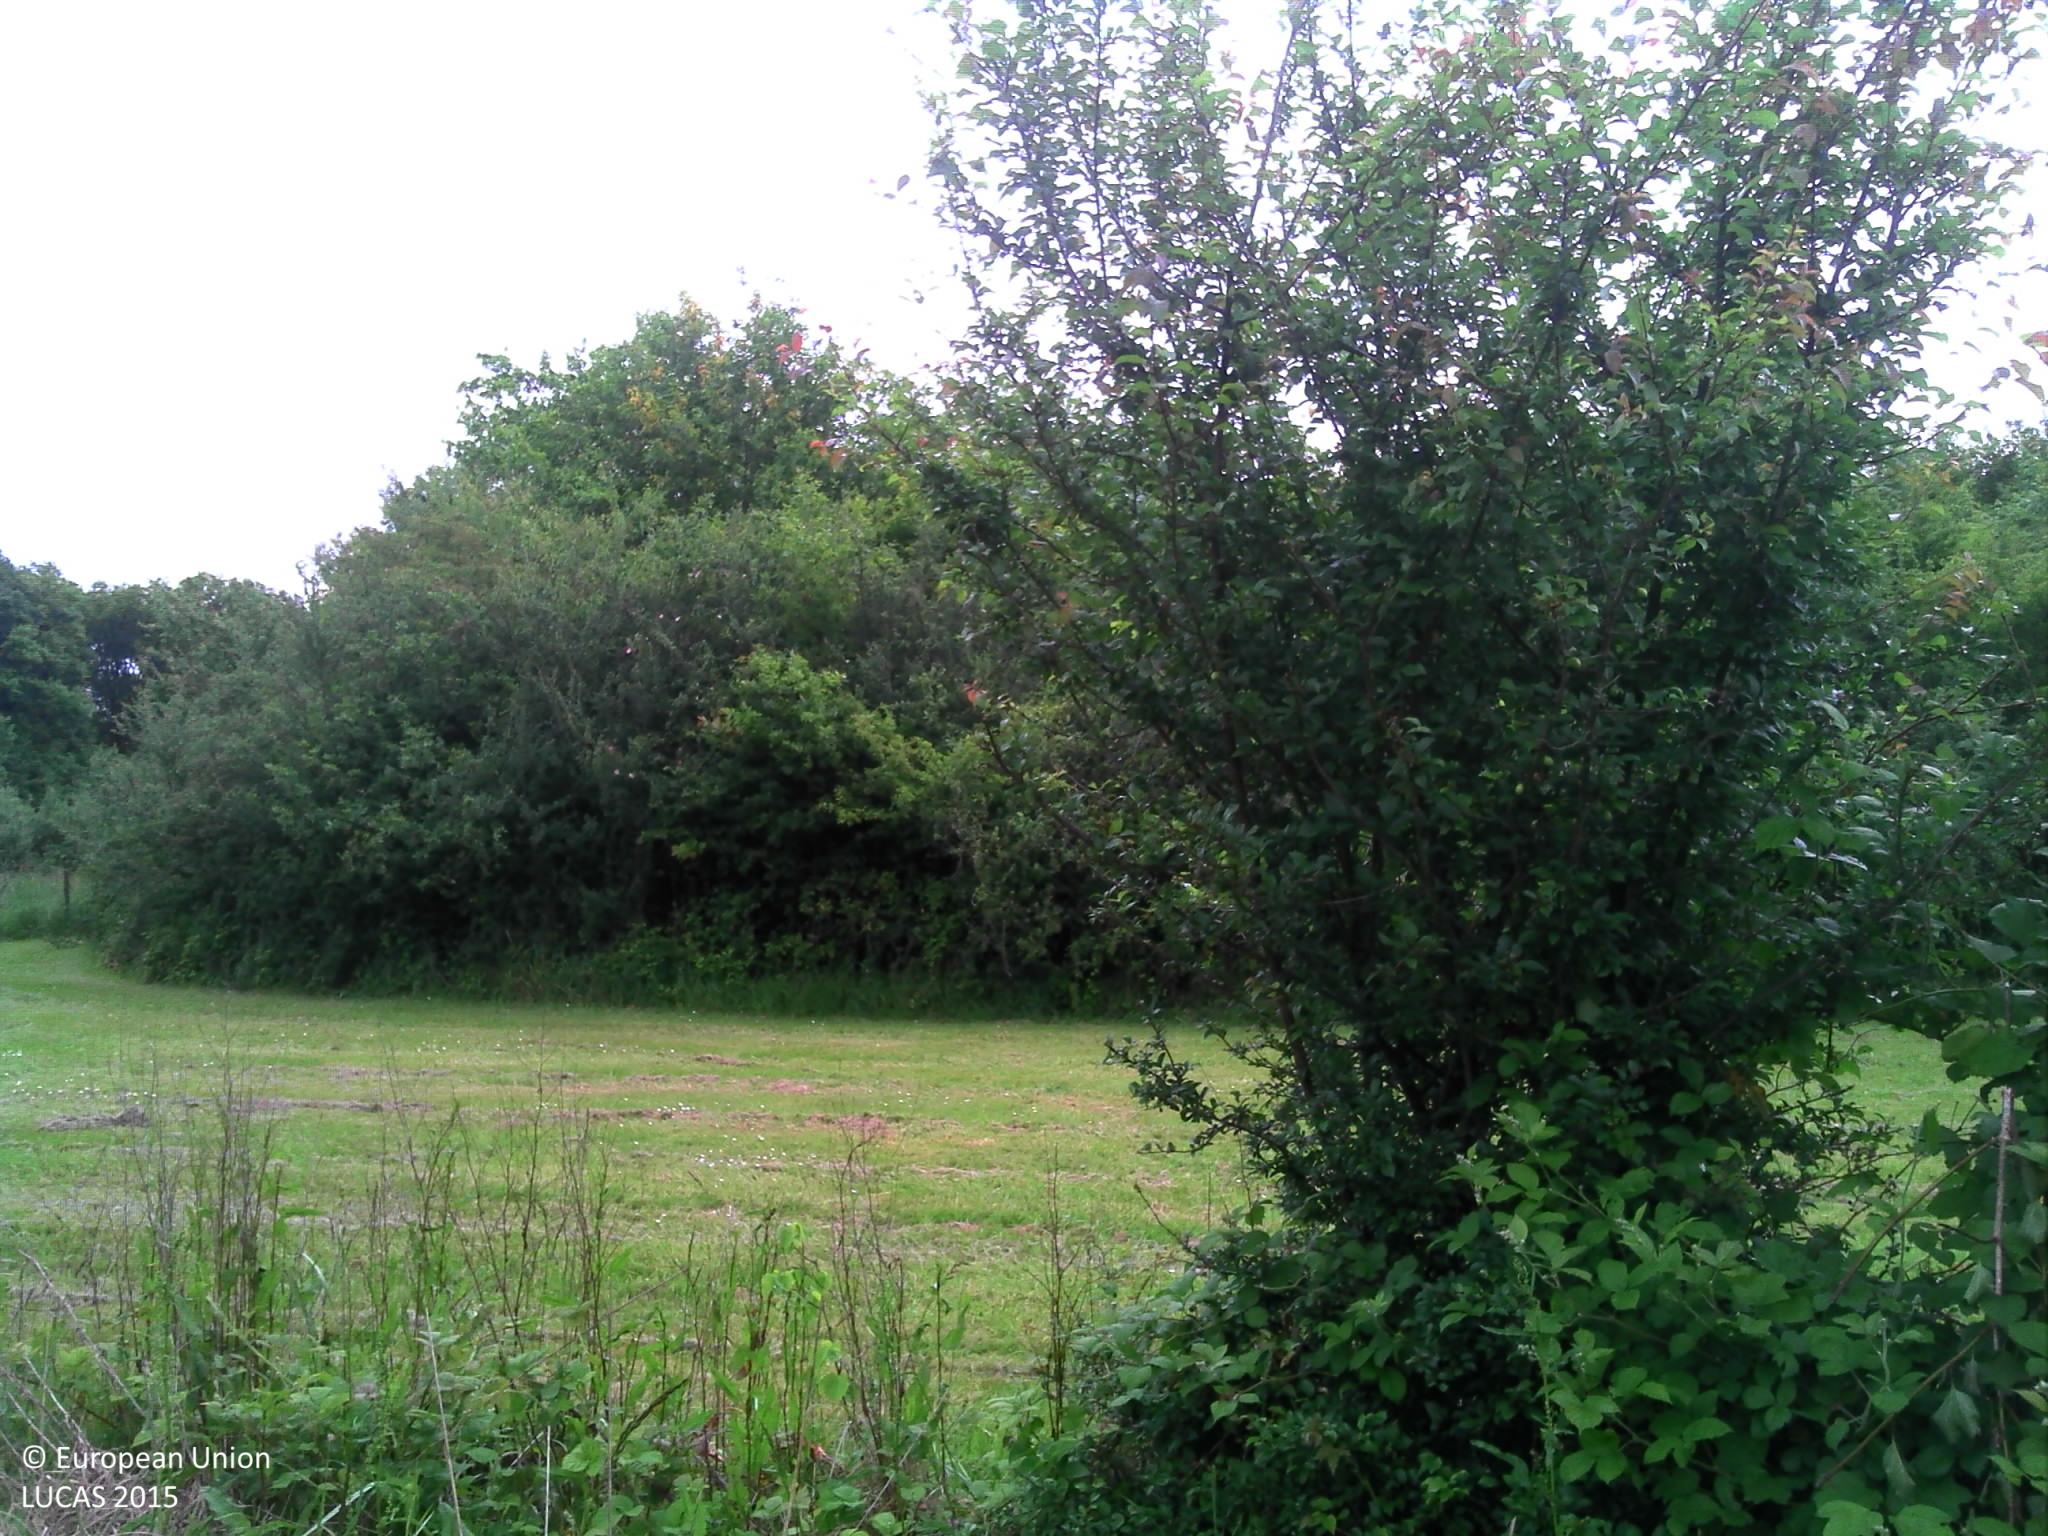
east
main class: Shrubland
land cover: Shrubland with sparse tree cover
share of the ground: > 75 %
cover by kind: shrubs 90 %, broadleaved forest trees 5 %, herbaceous plants 5 %
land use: Abandoned areas
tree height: < 5 m
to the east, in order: Shrubland with sparse tree cover; Fences; Shruby margins; Grassland without tree/shrub cover; Broadleaved woodland; Grassland without tree/shrub cover; Fences; Broadleaved woodland; Arable land (only in case pi)
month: May
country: FR
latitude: 47.5973
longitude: 0.7368
